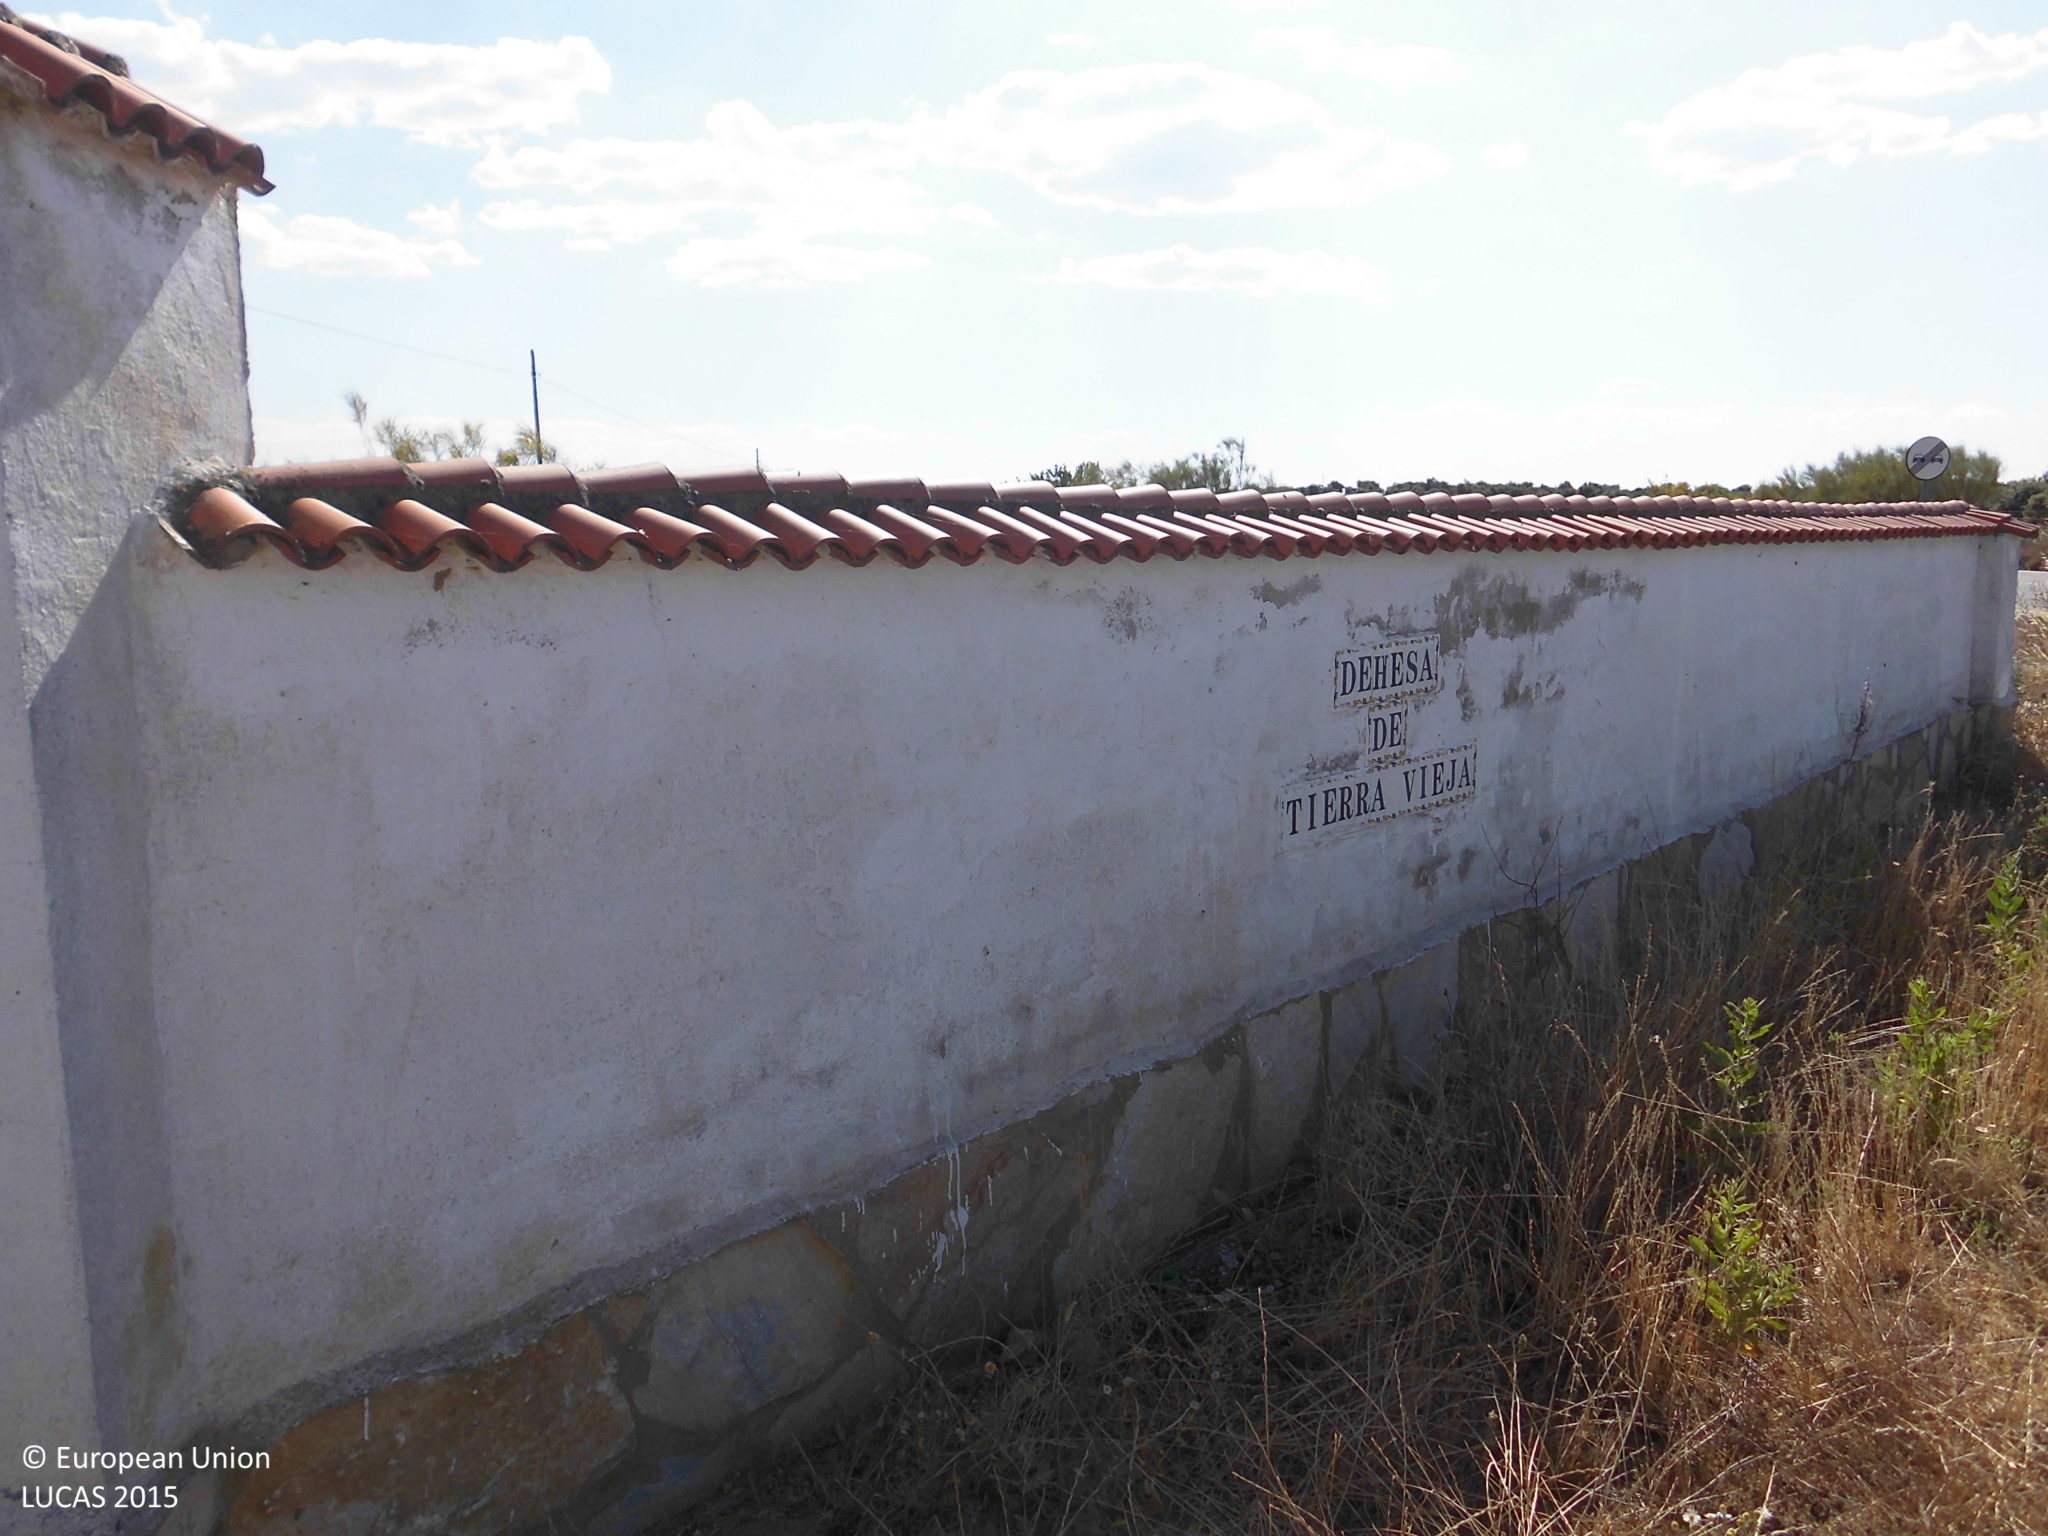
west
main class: Shrubland
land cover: Shrubland without tree cover
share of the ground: 10 - 25 %
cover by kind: herbaceous plants 85 %, shrubs 15 %
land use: Agriculture (excluding fallow land and kitchen gardens)
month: May
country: ES
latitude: 39.9248
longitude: -6.5177
